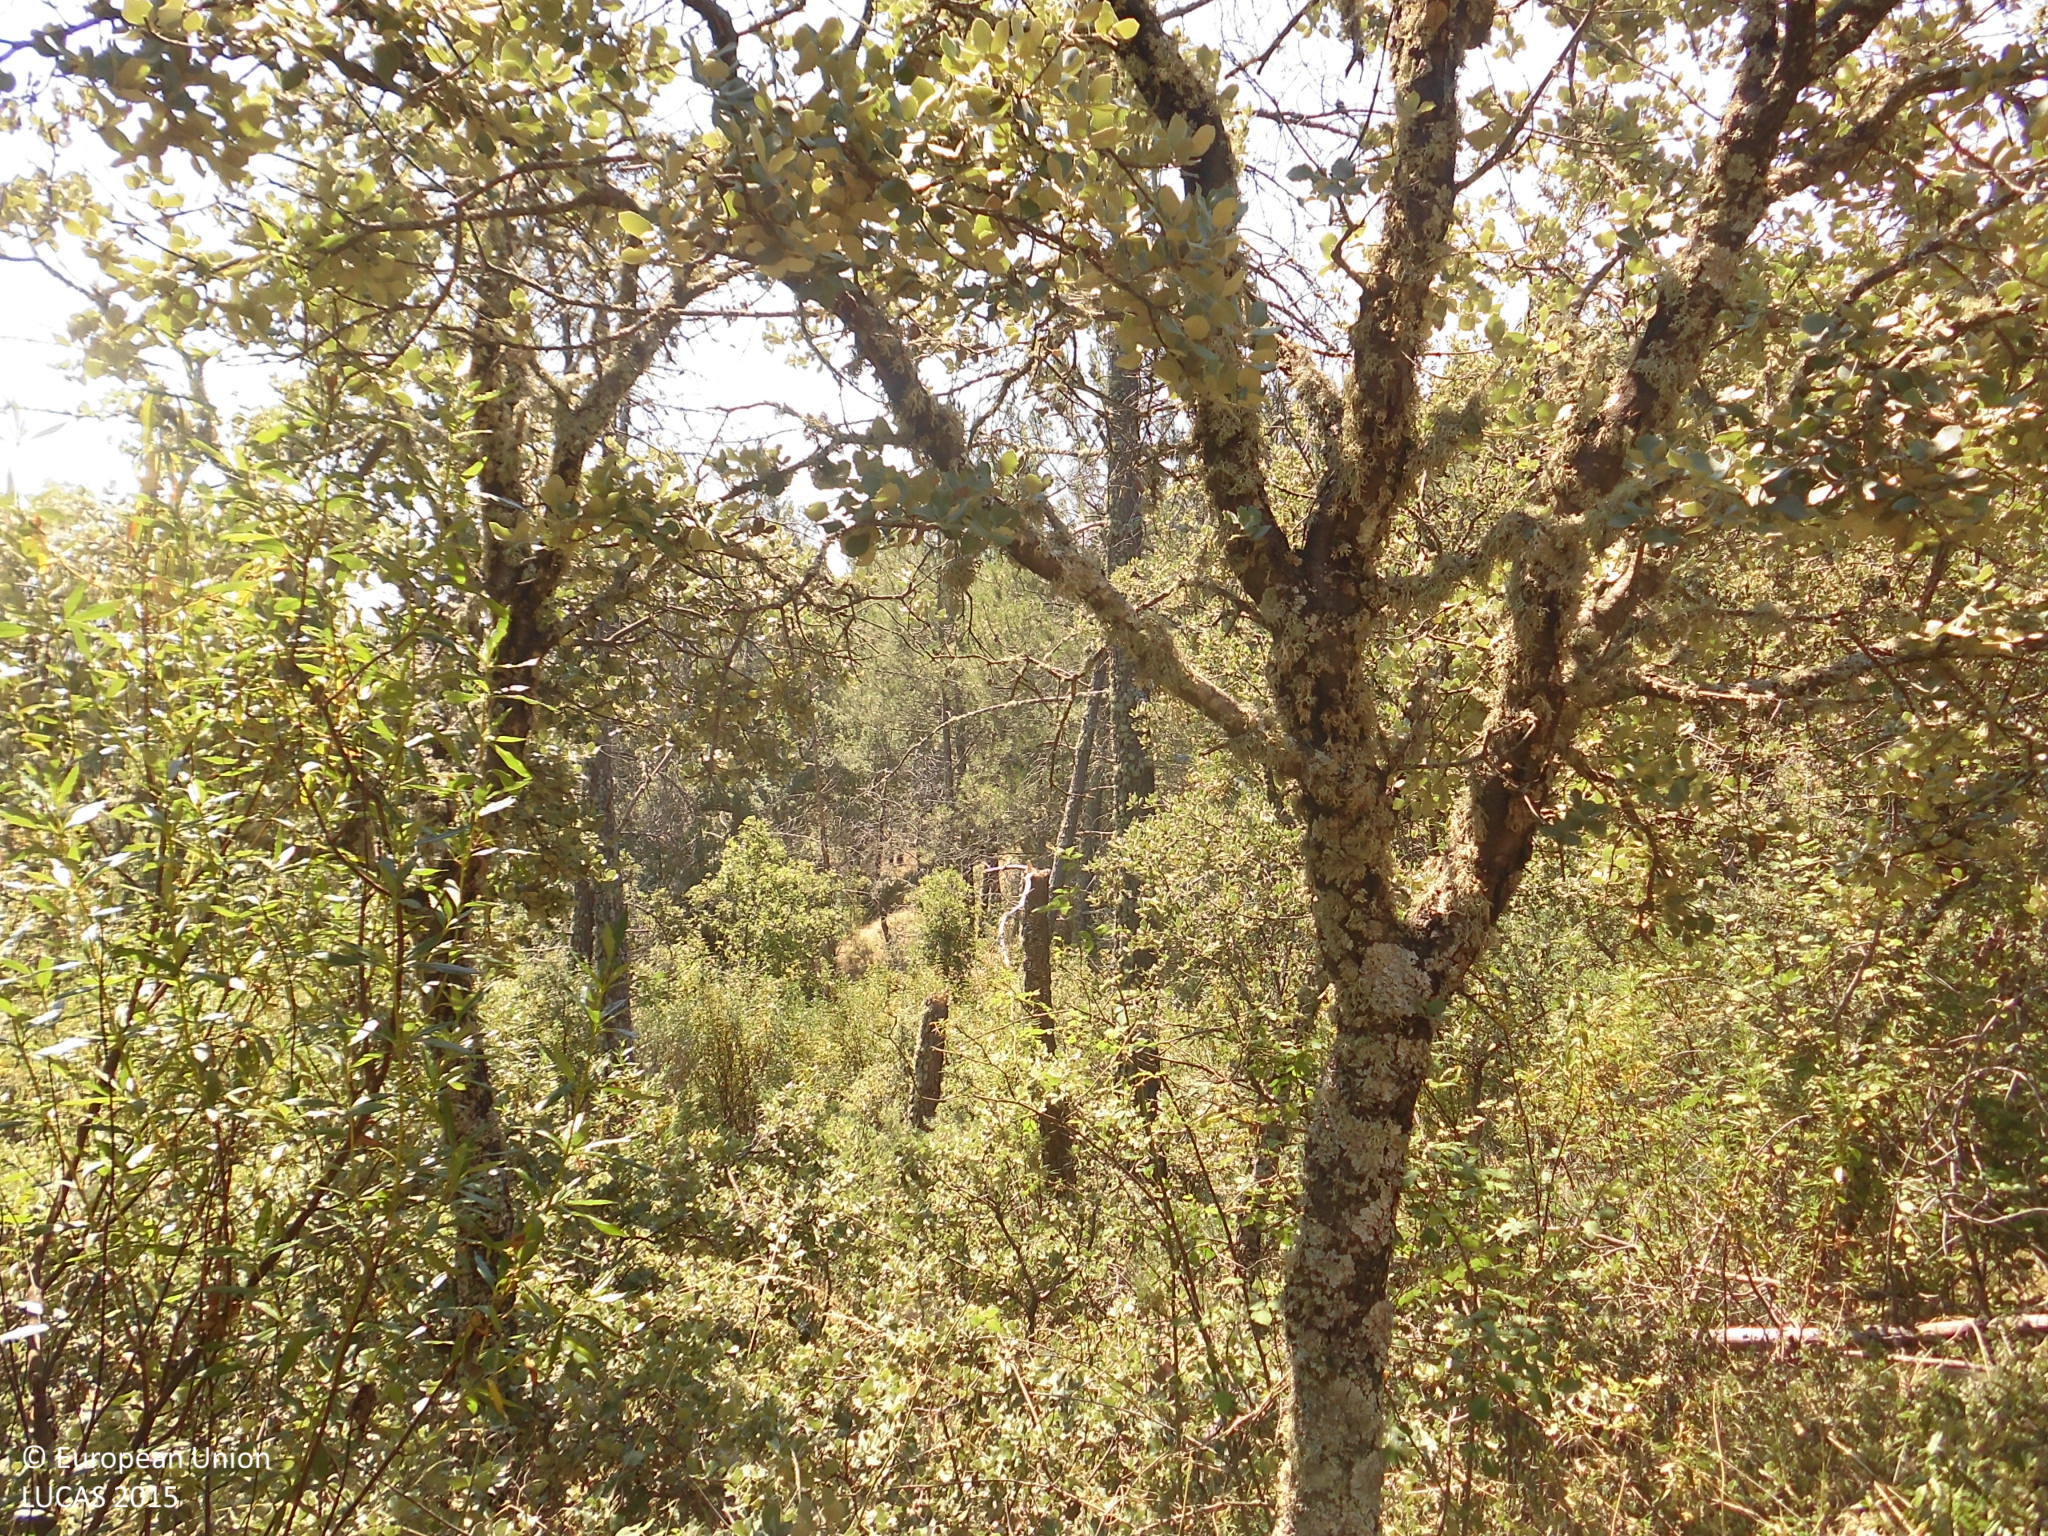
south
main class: Woodland
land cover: Pine dominated mixed woodland
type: coniferous forest of the mediterranean region
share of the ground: > 75 %
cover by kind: coniferous forest trees 40 %, broadleaved forest trees 30 %, shrubs 20 %, herbaceous plants 10 %
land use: Semi-natural and natural areas not in use
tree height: > 5 m
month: June
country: ES
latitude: 39.5472
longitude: -5.3525
